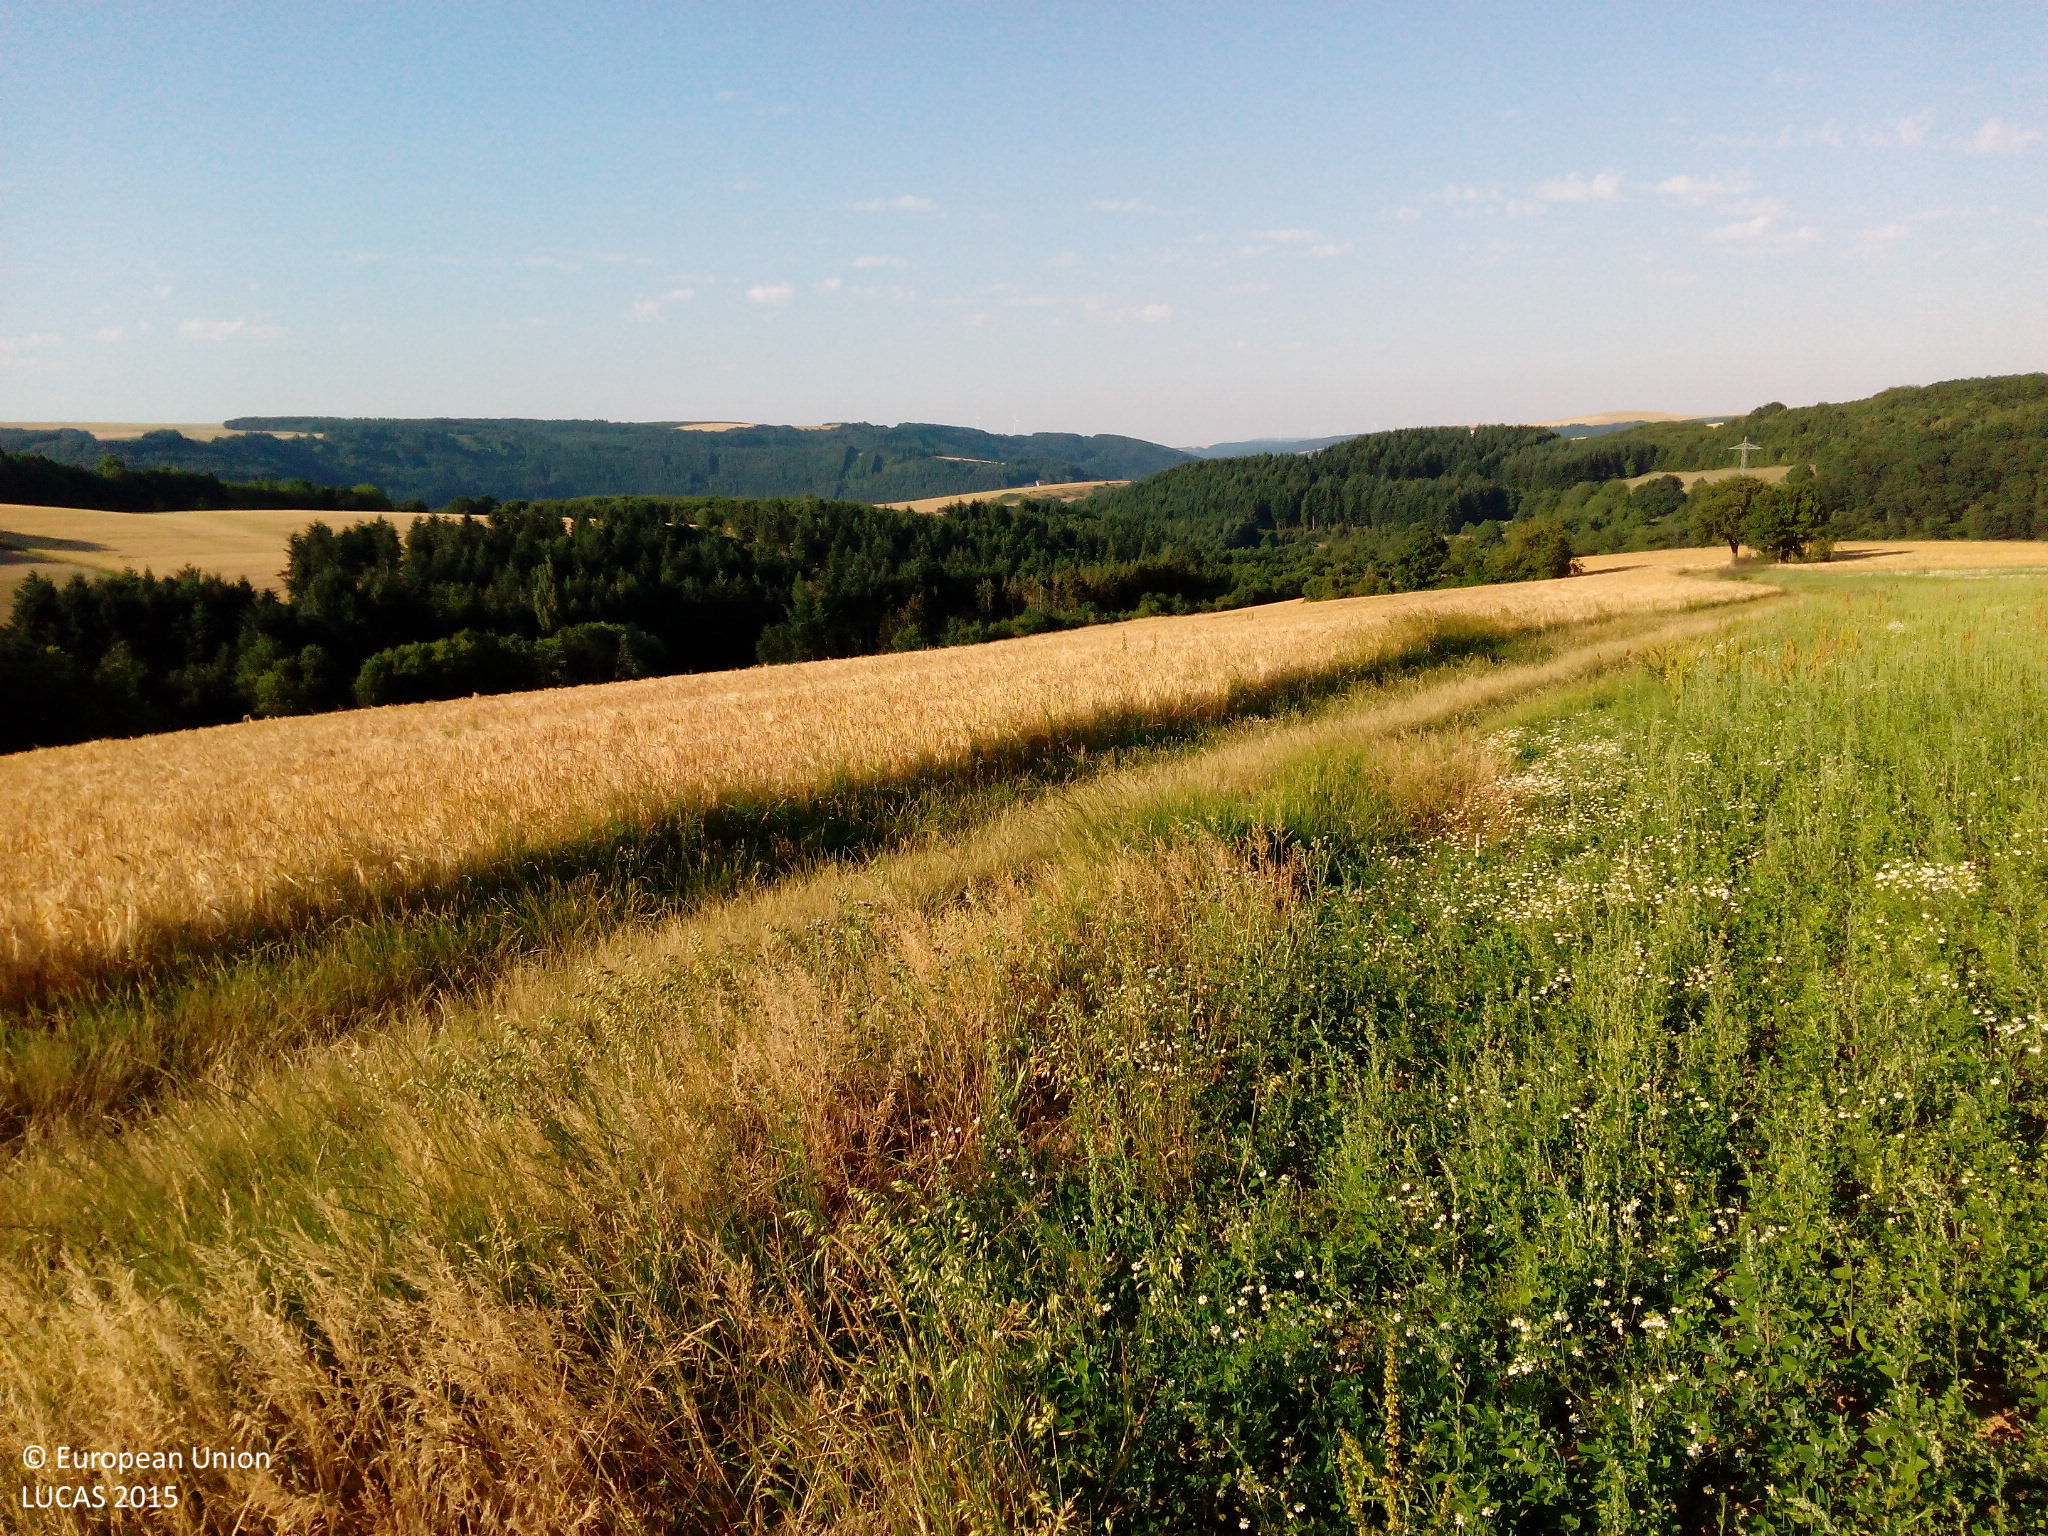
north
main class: Cropland
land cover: Clovers
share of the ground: > 75 %
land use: Agriculture (excluding fallow land and kitchen gardens)
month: July
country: DE
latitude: 49.5996
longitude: 7.5237
